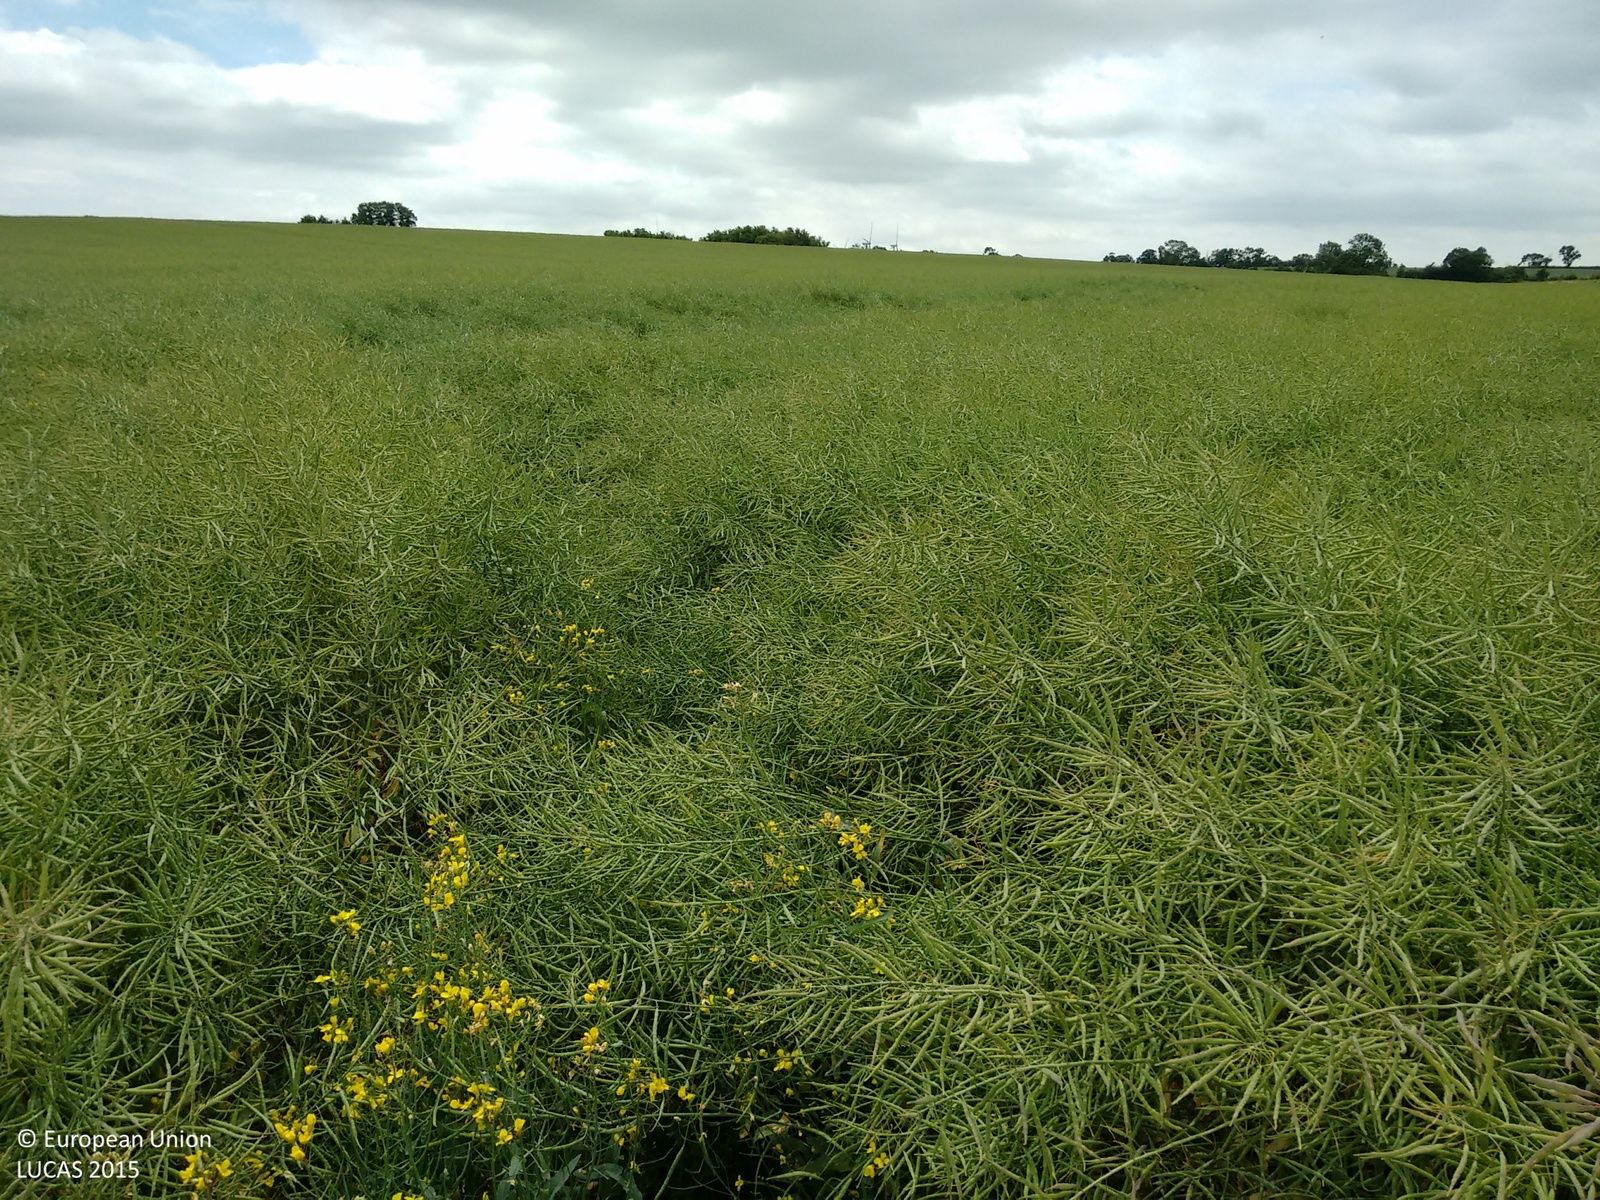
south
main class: Cropland
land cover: Rape and turnip rape
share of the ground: > 75 %
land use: Agriculture (excluding fallow land and kitchen gardens)
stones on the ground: < 10 %
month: June
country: GB
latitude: 52.1495
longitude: -0.6651
